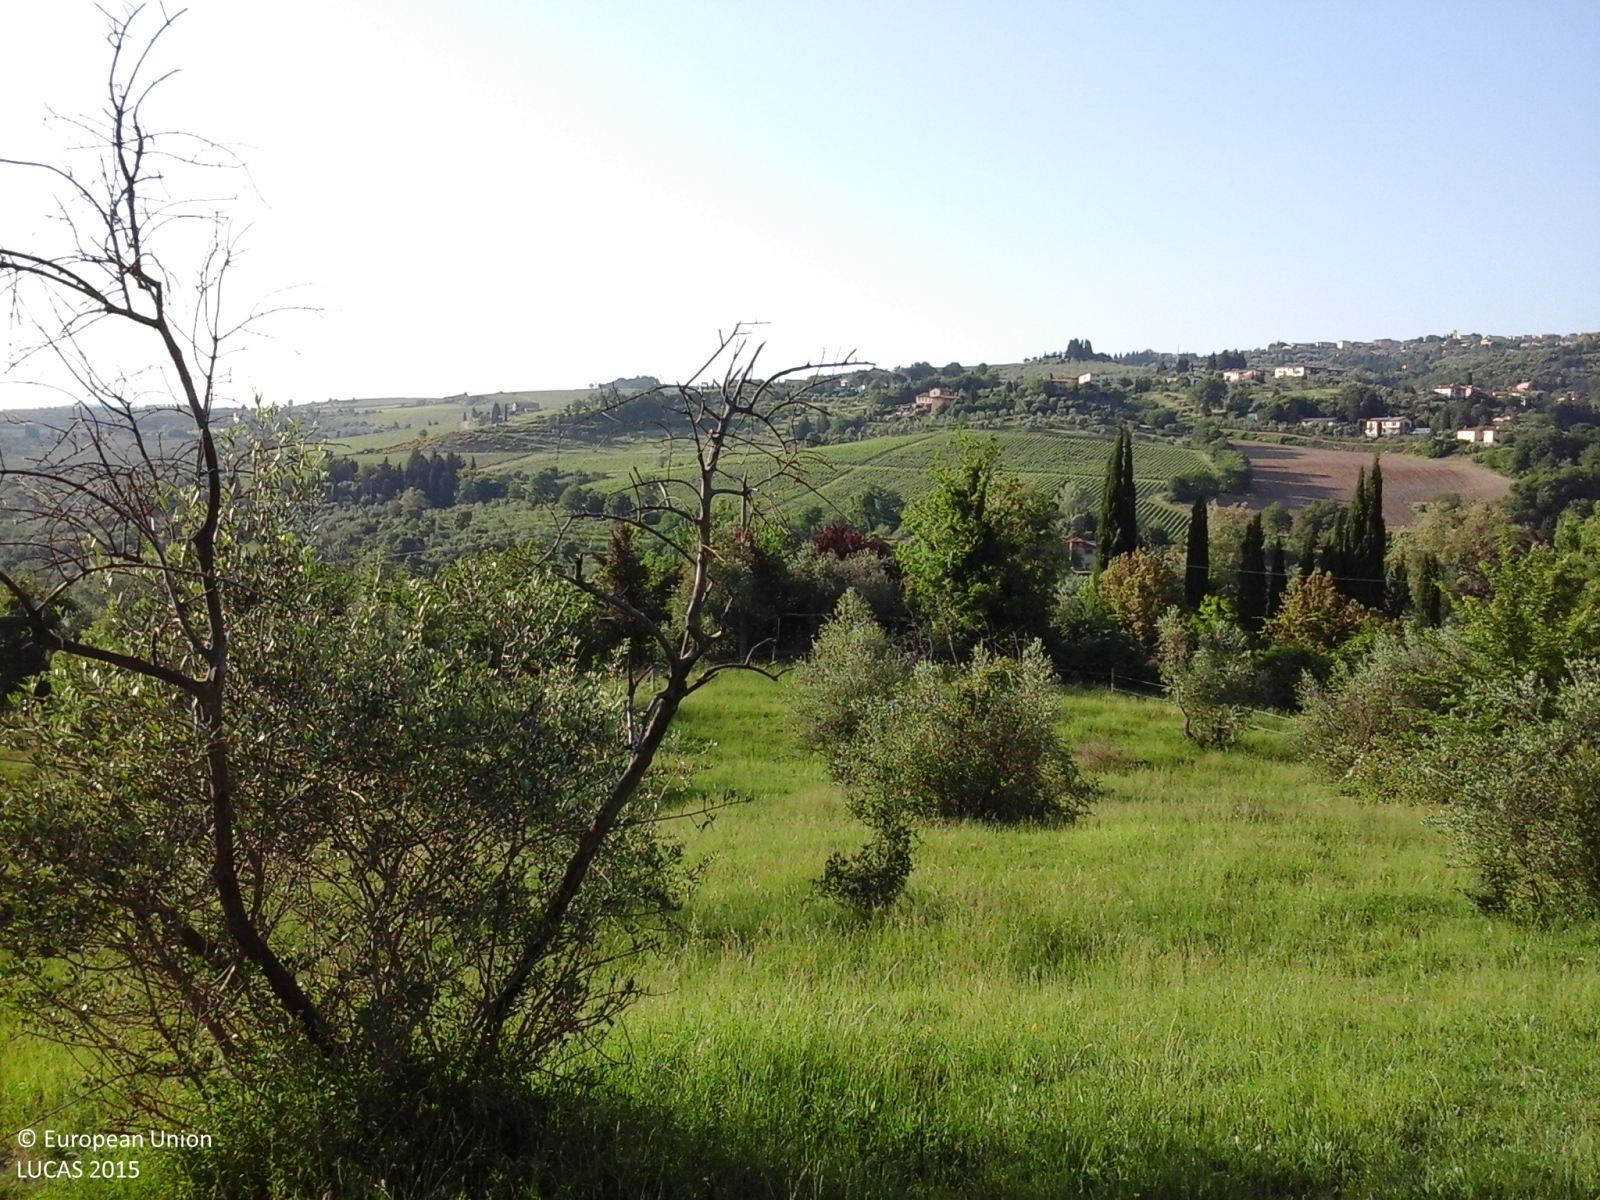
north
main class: Cropland
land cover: Olive groves
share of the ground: 25 - 50 %
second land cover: Grassland without tree/shrub cover
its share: 50 - 75 %
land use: Agriculture (excluding fallow land and kitchen gardens)
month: May
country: IT
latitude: 43.7624
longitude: 11.4991
